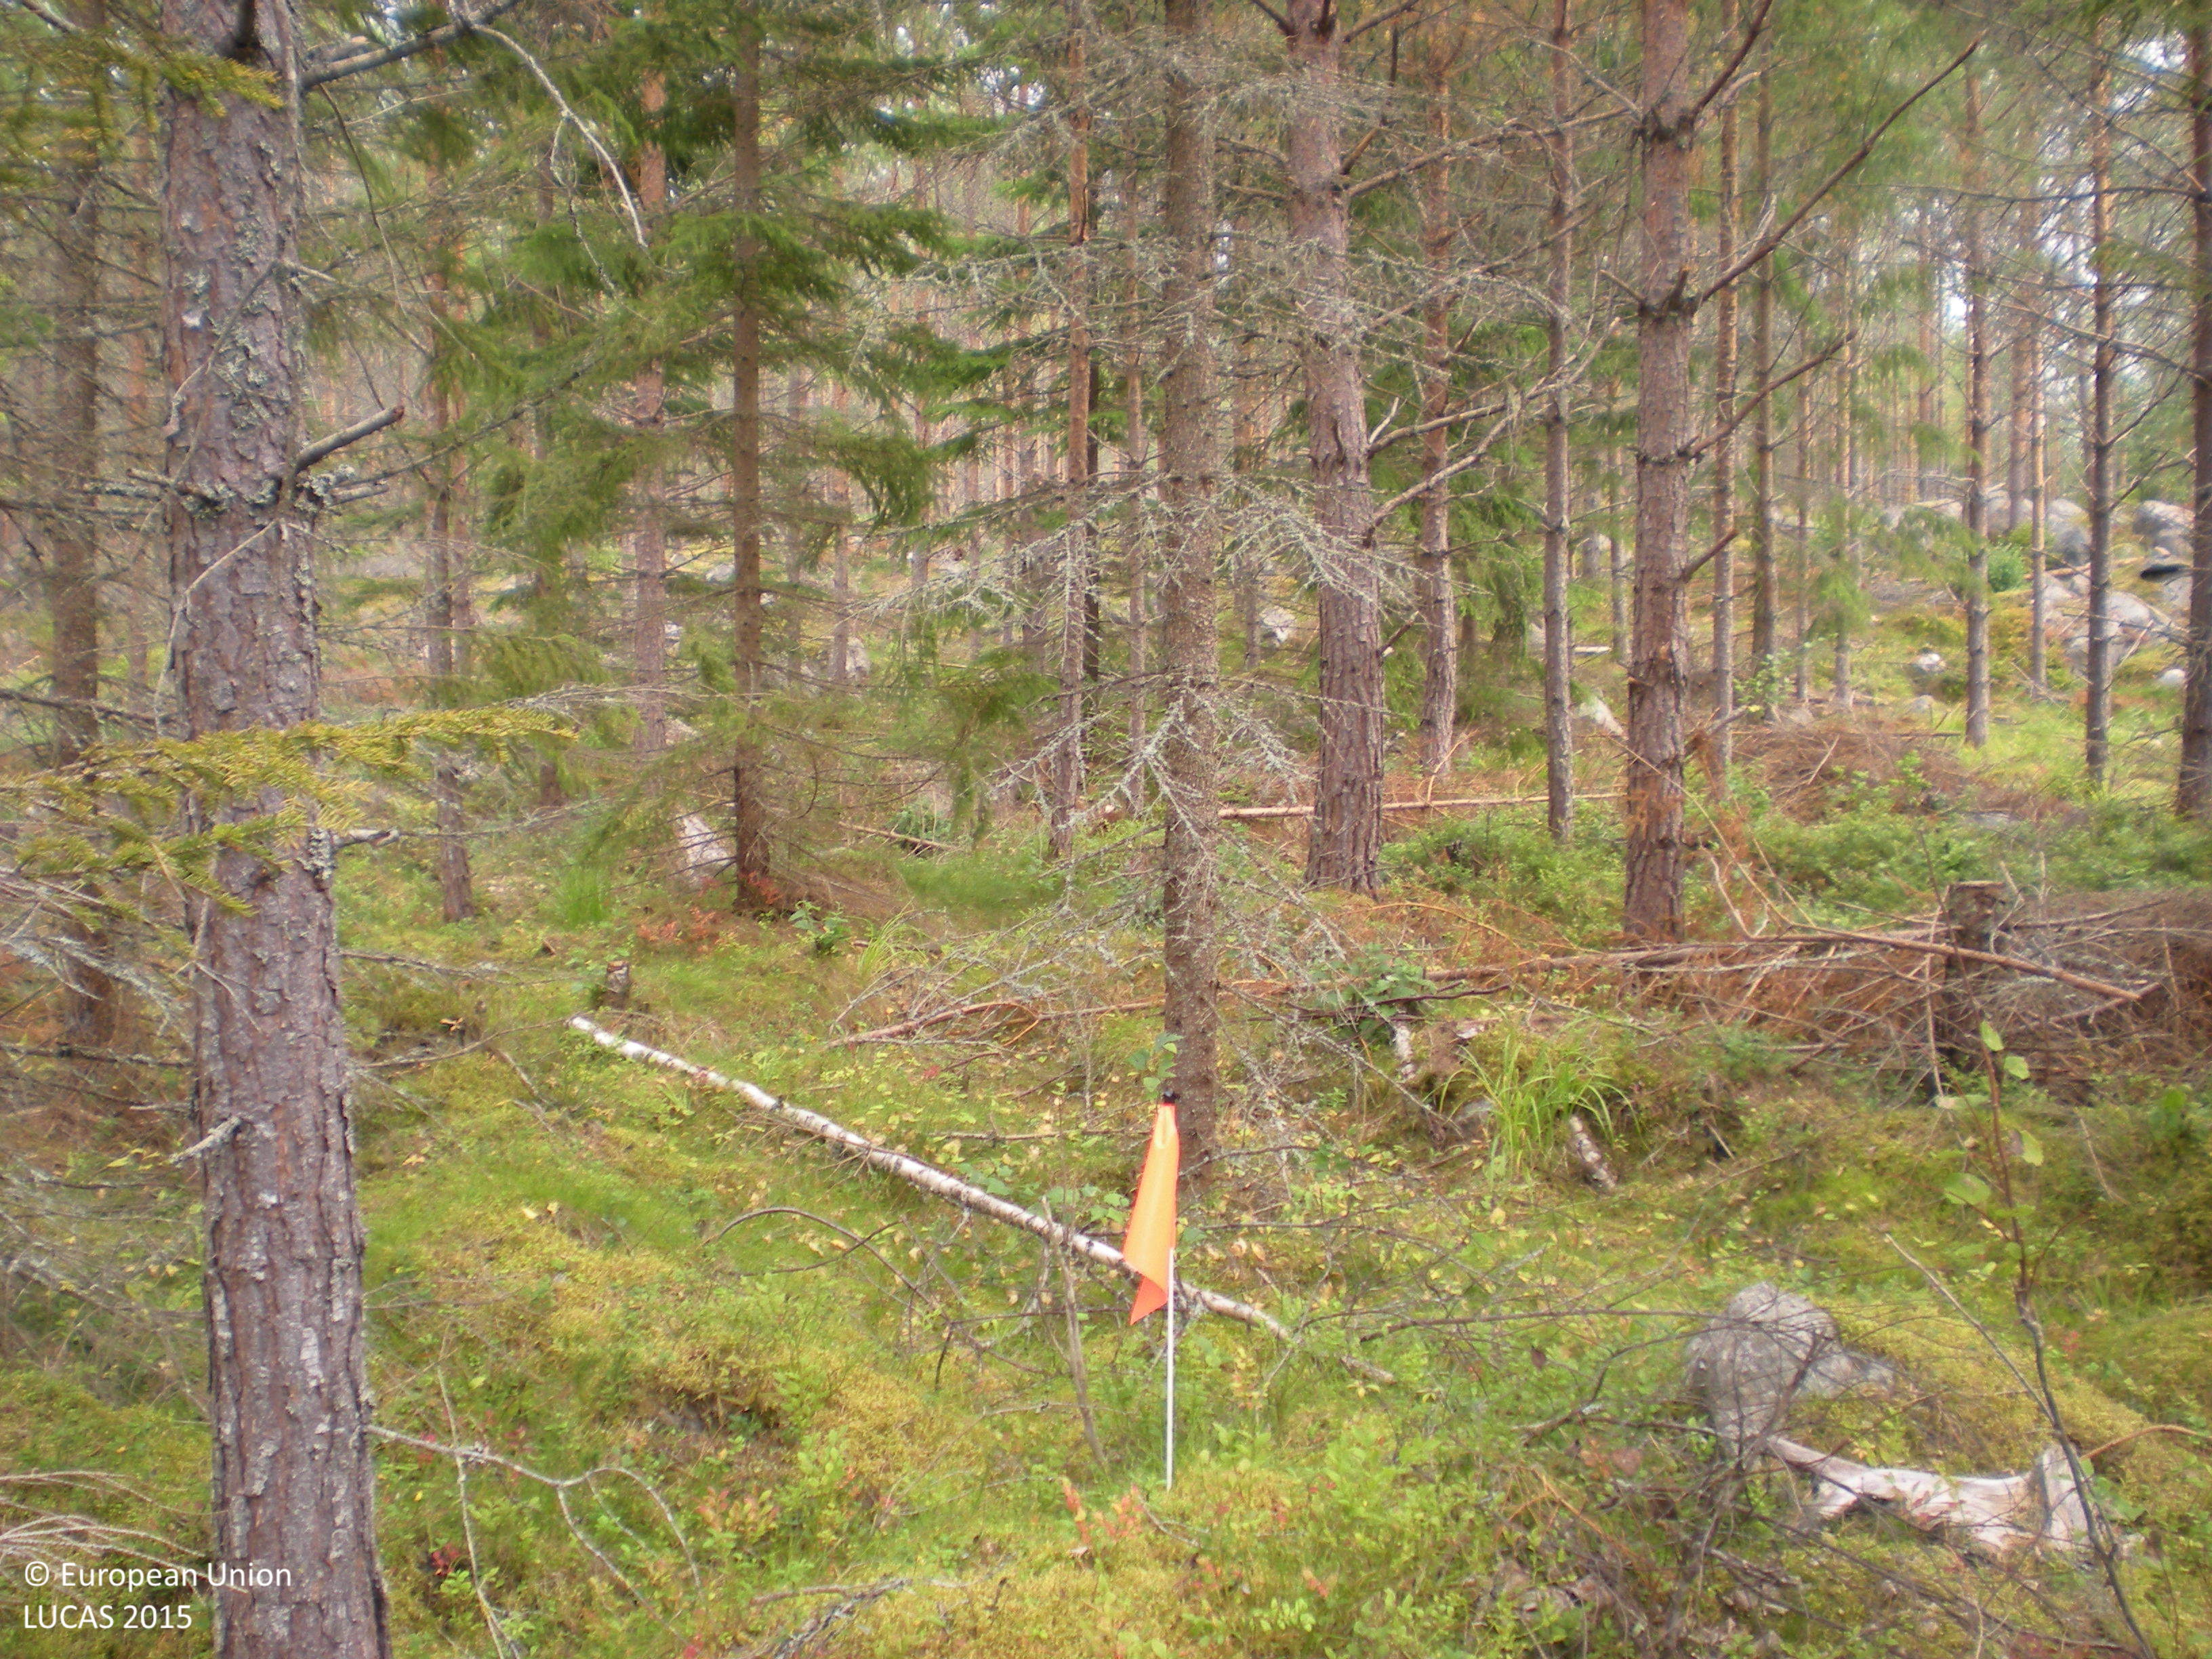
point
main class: Woodland
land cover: Other coniferous woodland
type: boreal forest
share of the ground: 50 - 75 %
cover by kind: coniferous forest trees 60 %, lichens and mosses 15 %, shrubs 10 %, broadleaved forest trees 5 %, herbaceous plants 5 %, consolidated bare surface 5 %
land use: Forestry
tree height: > 5 m
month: August
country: SE
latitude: 60.4419
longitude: 17.6790
